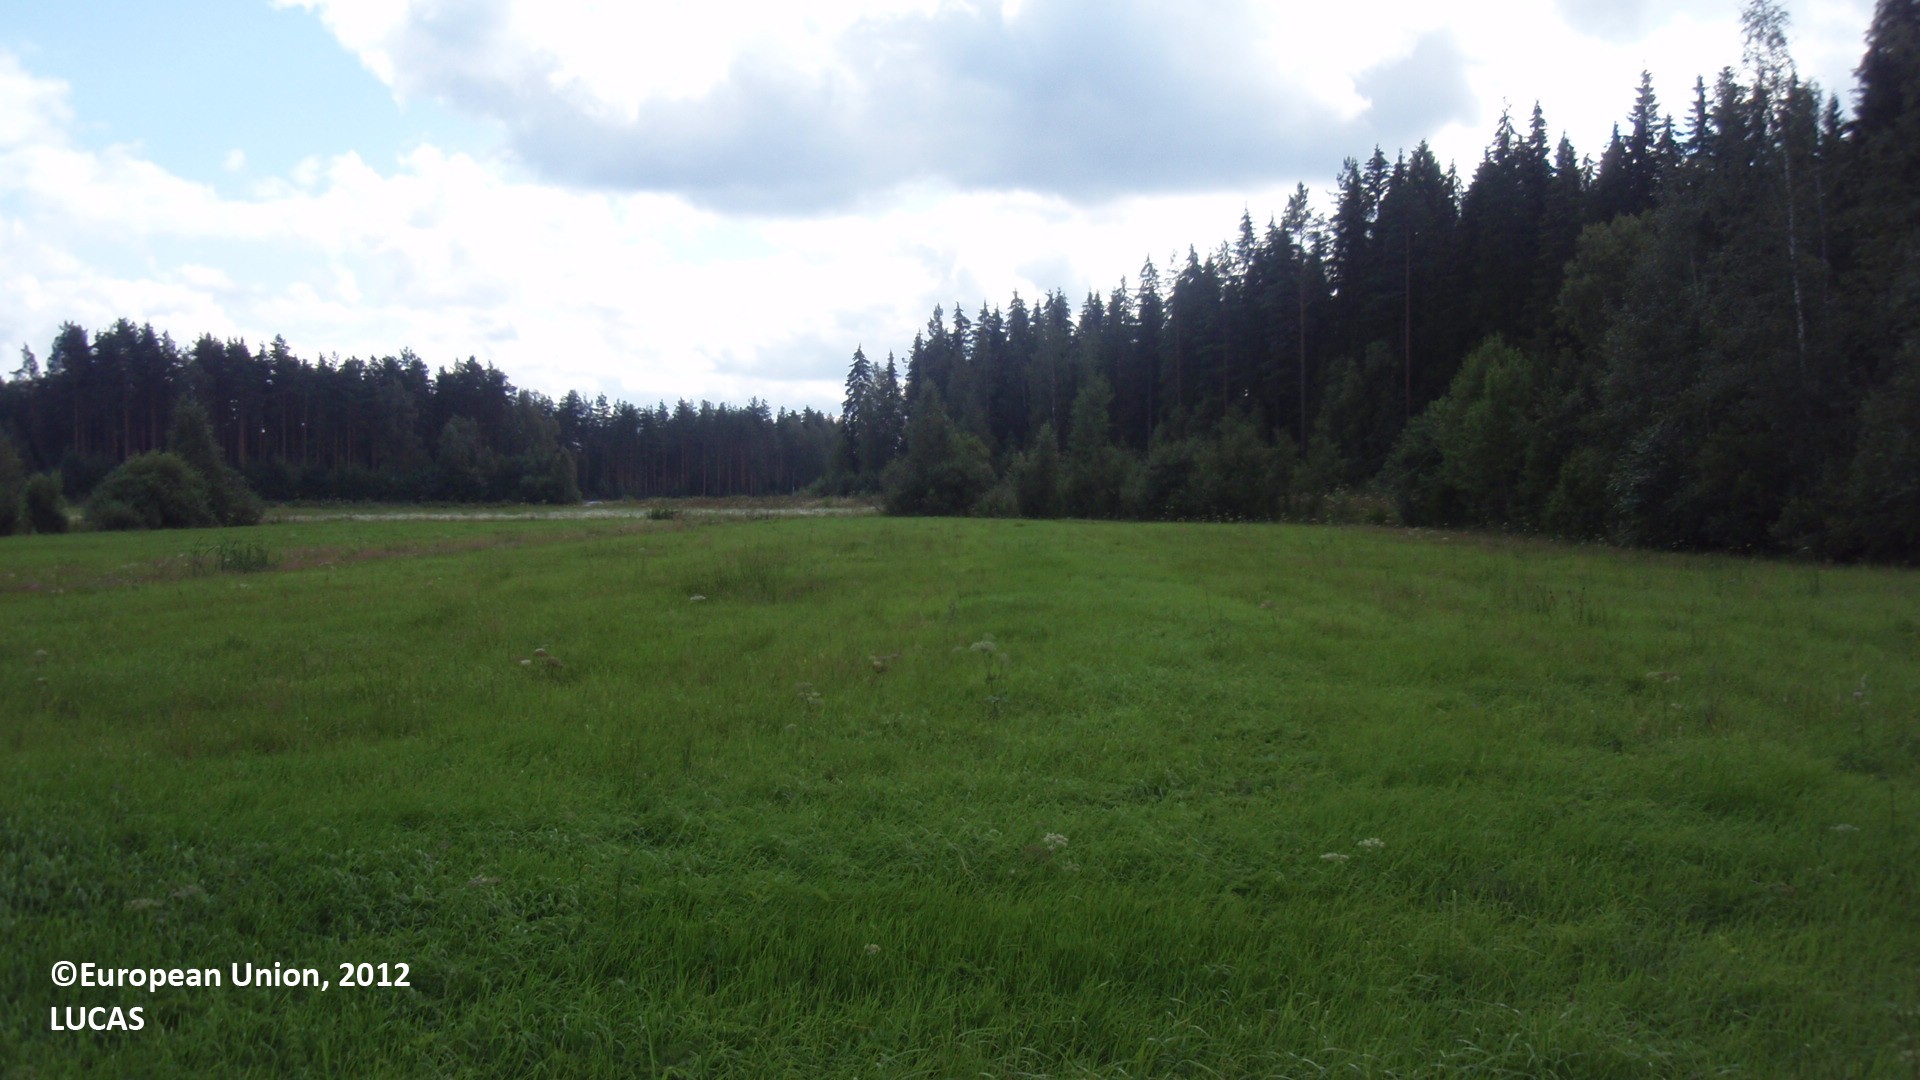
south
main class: Cropland
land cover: Oats
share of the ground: > 75 %
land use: Agriculture (excluding fallow land and kitchen gardens)
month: July
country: FI
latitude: 60.9667
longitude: 28.4848
